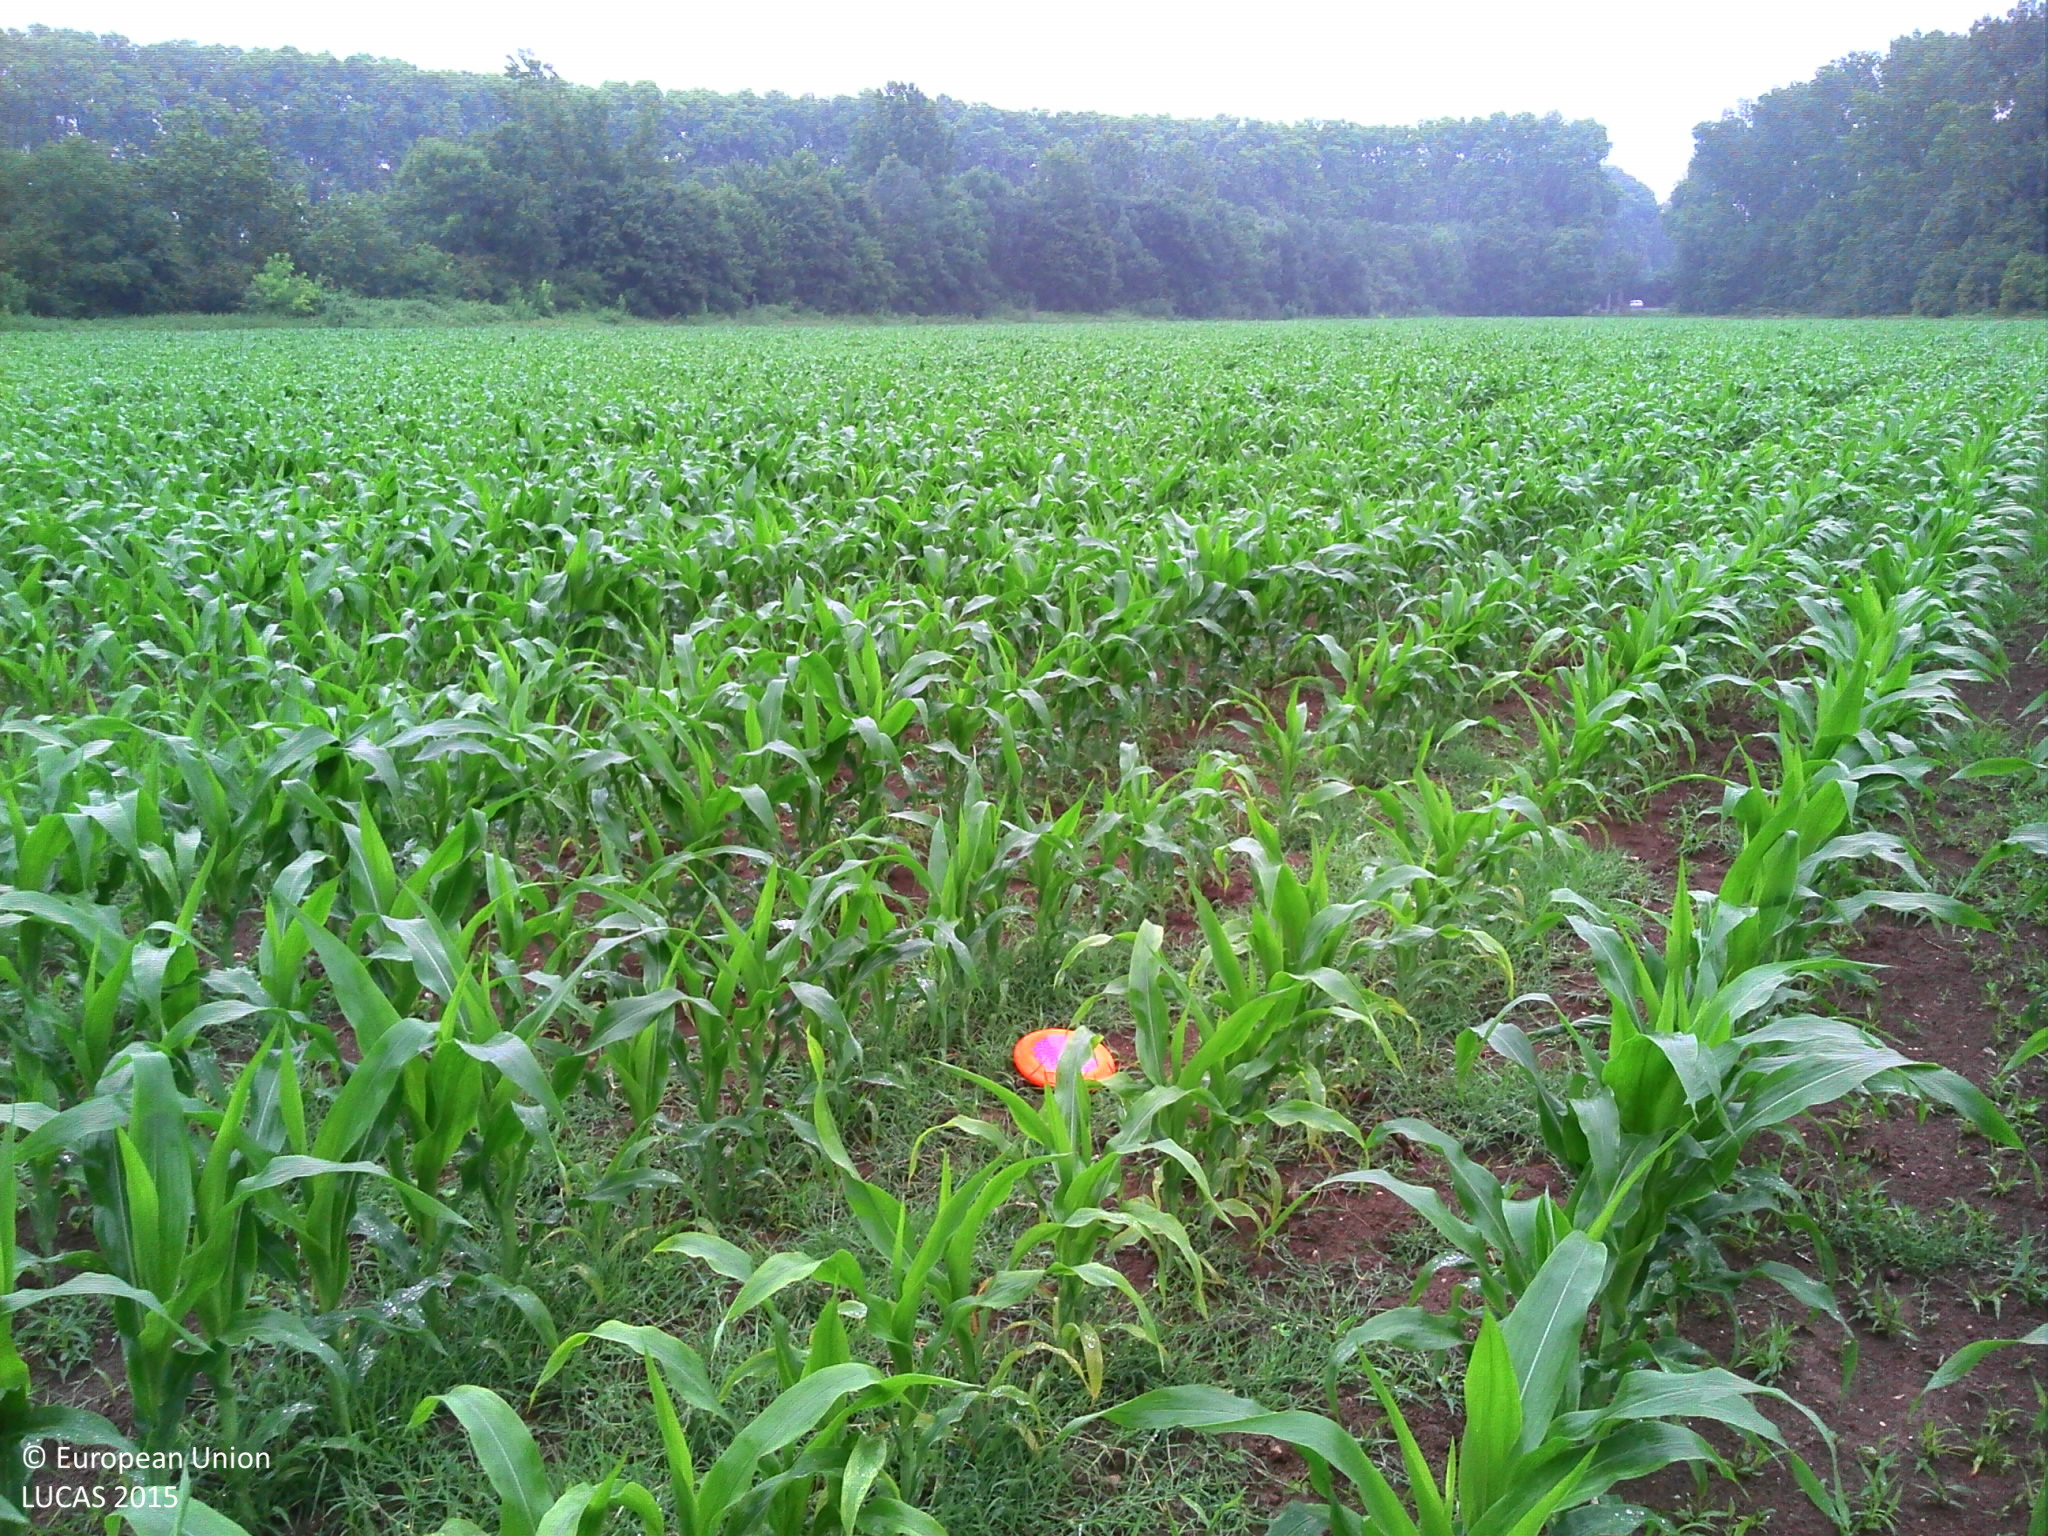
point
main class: Cropland
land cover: Maize
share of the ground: 25 - 50 %
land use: Agriculture (excluding fallow land and kitchen gardens)
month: June
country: FR
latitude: 46.7000
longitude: 0.4209
